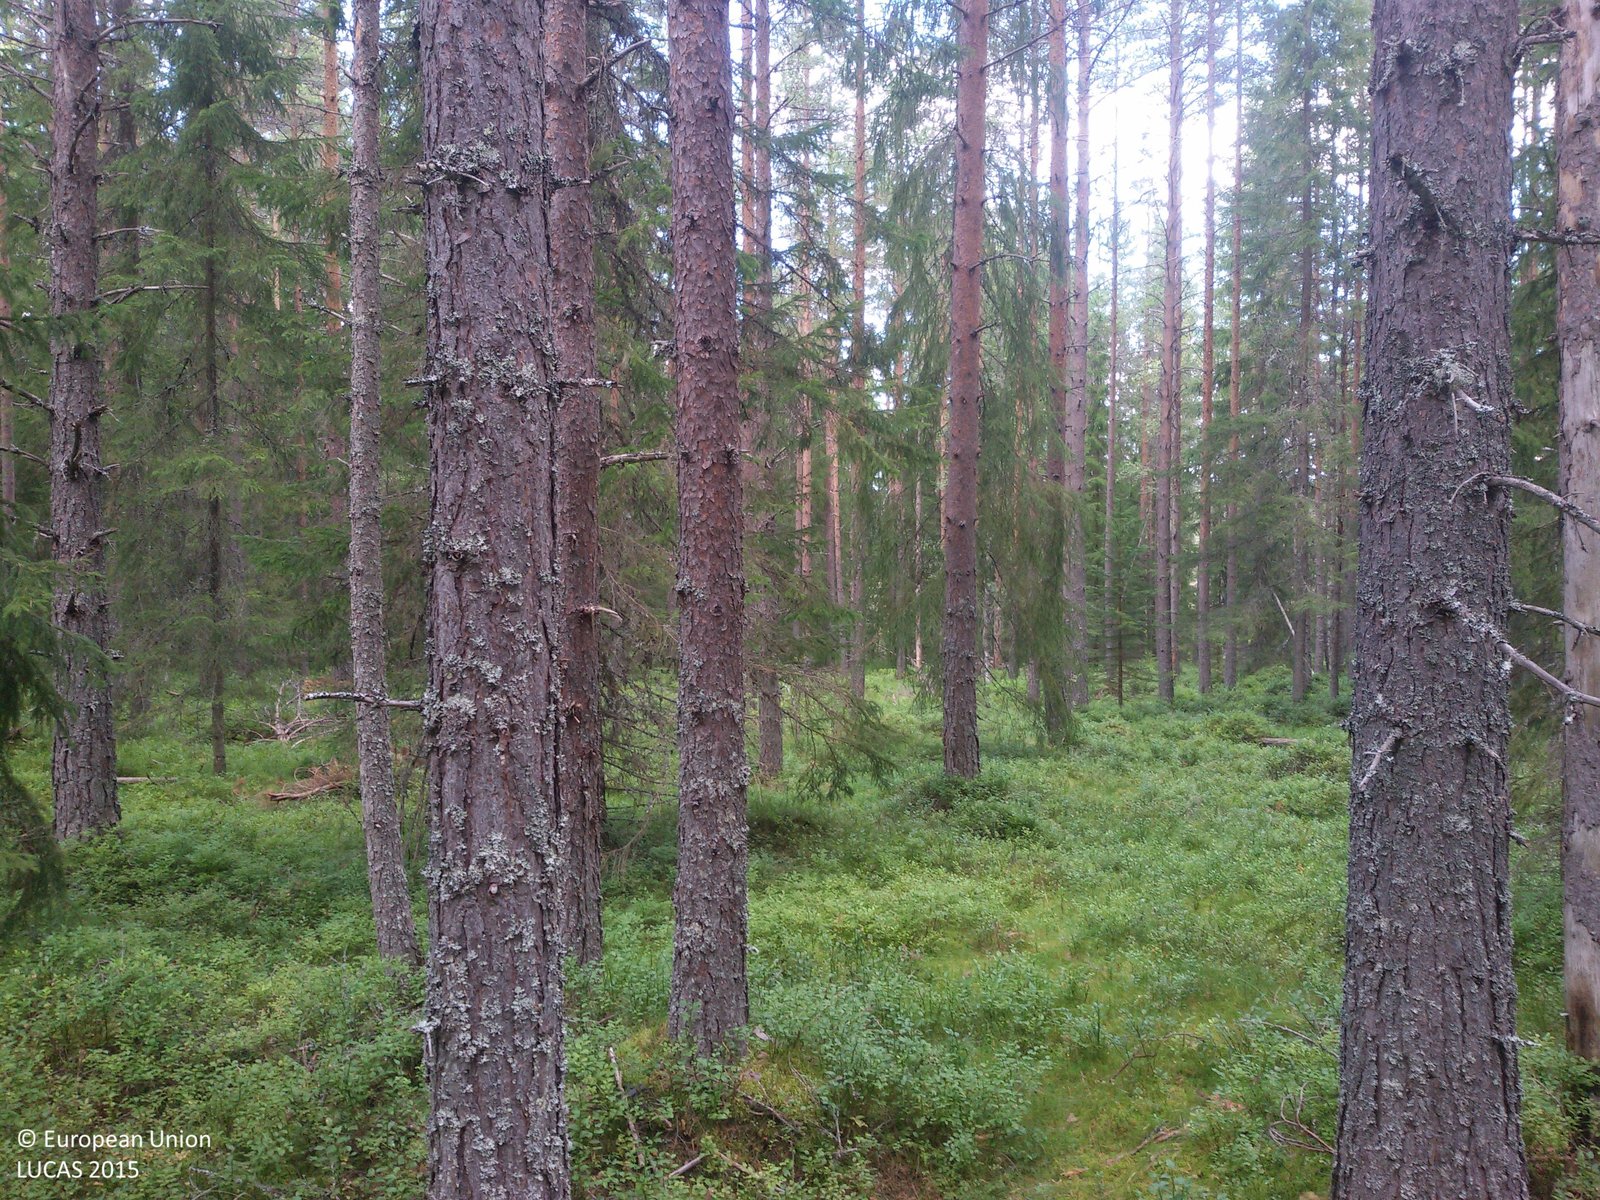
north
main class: Woodland
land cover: Pine dominated coniferous woodland
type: boreal forest
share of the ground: 50 - 75 %
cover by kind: coniferous forest trees 60 %, shrubs 20 %, herbaceous plants 10 %, lichens and mosses 10 %
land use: Forestry
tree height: > 5 m
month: August
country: SE
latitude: 60.7977
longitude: 15.4438
